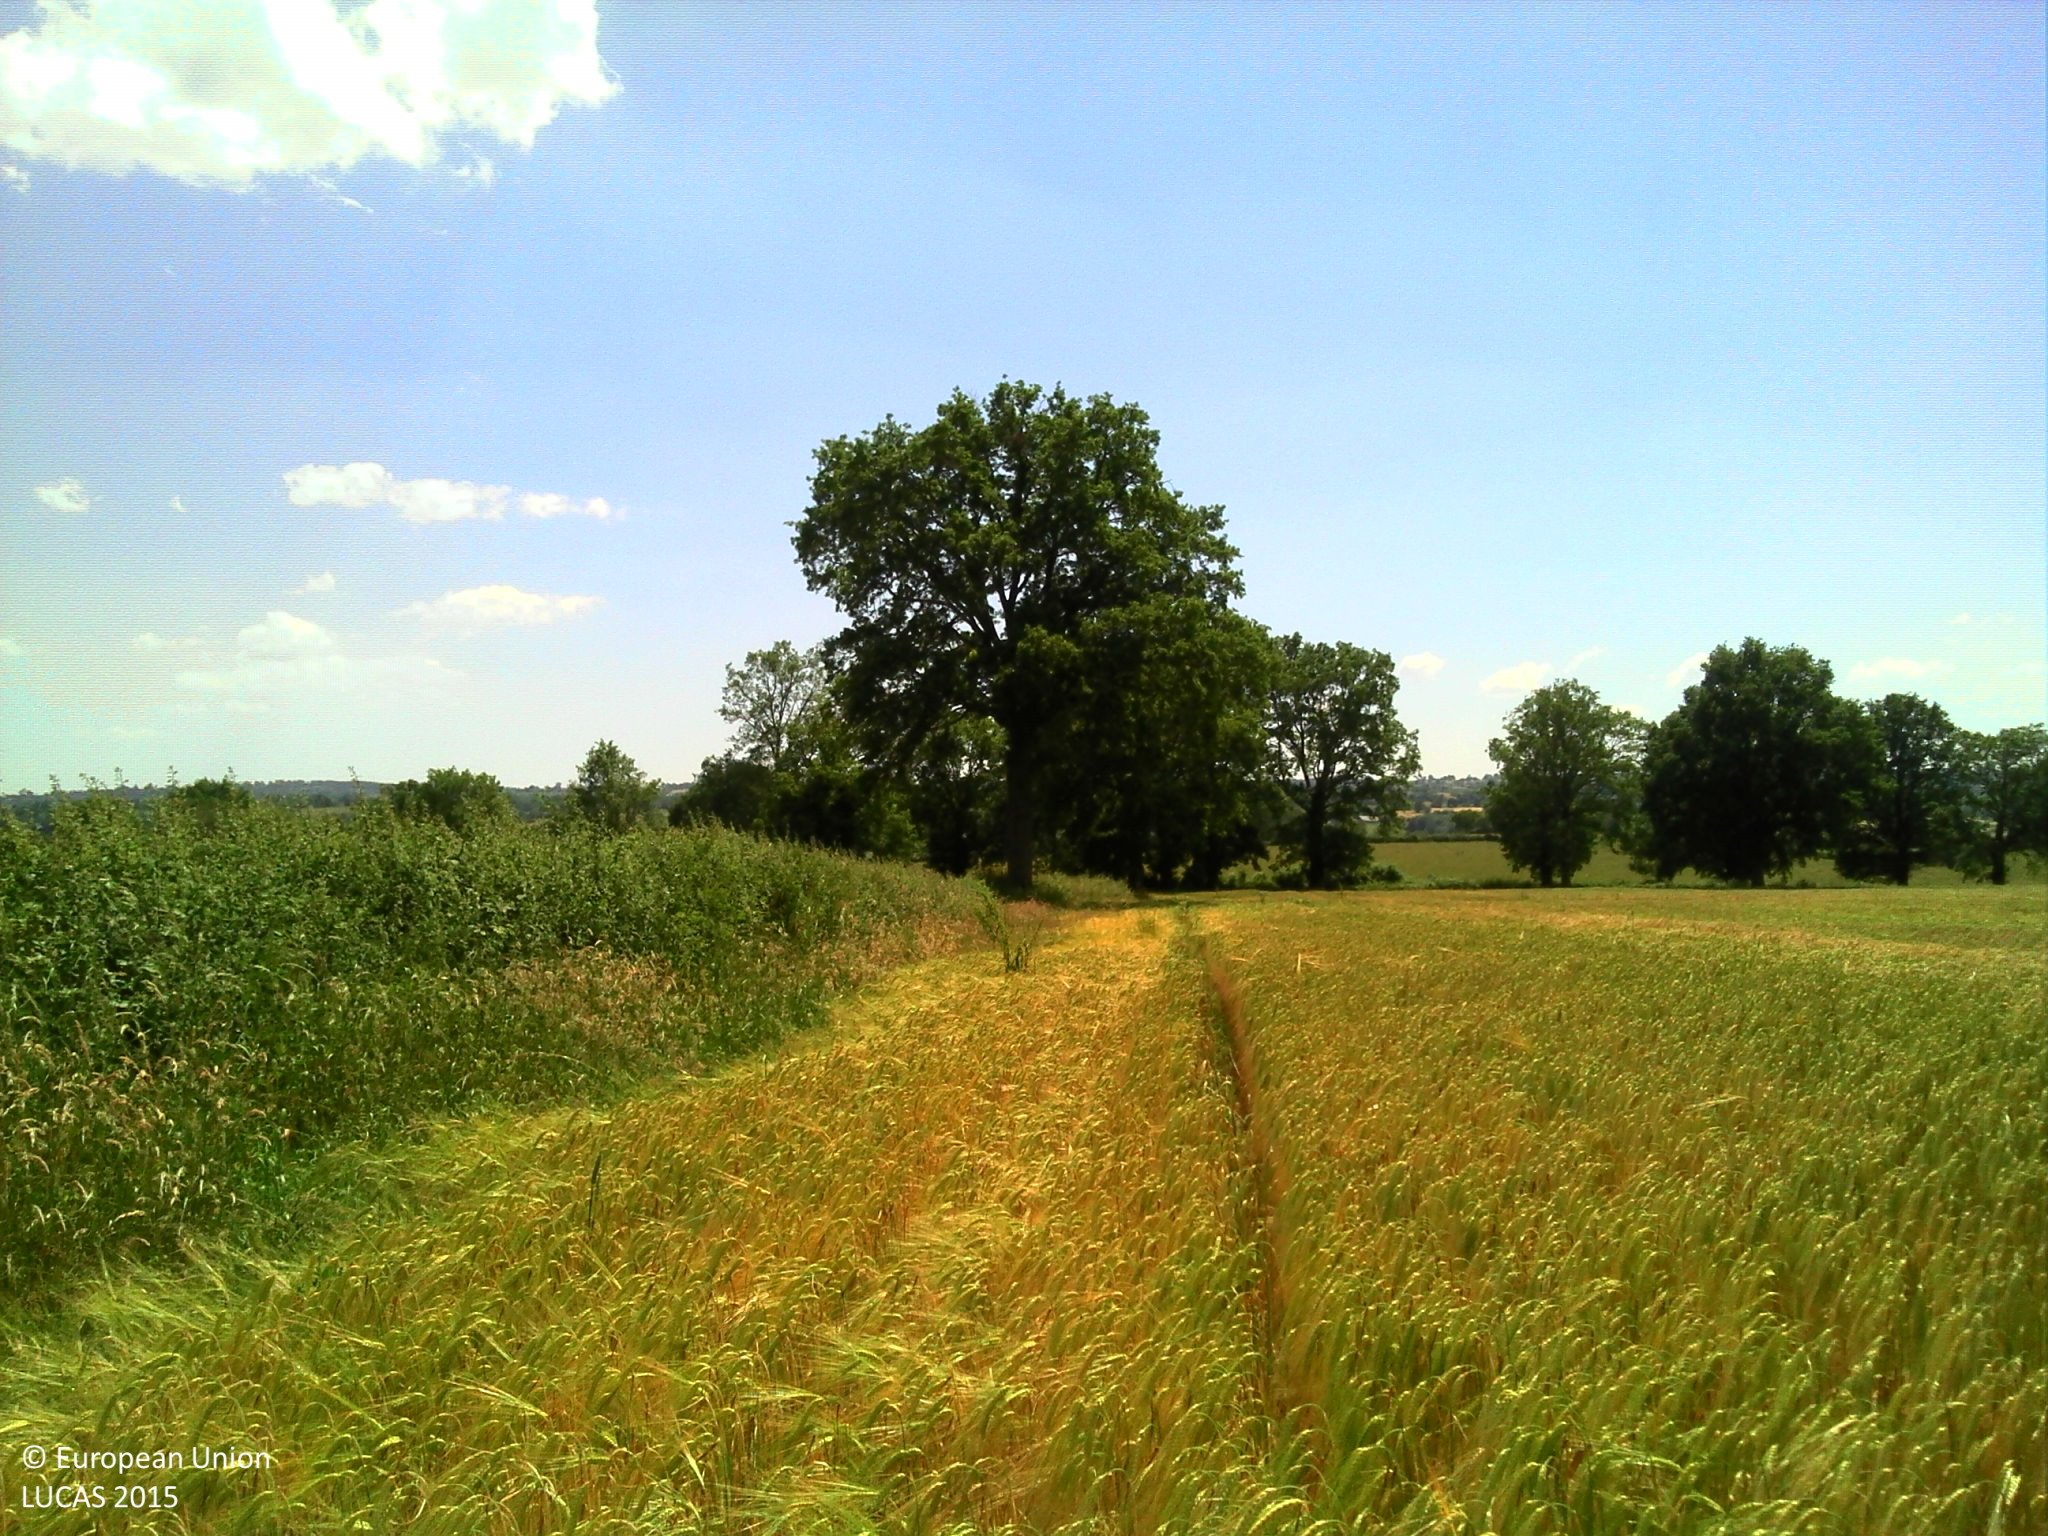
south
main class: Cropland
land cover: Barley
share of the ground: > 75 %
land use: Agriculture (excluding fallow land and kitchen gardens)
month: June
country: FR
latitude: 46.3298
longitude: 2.8657
